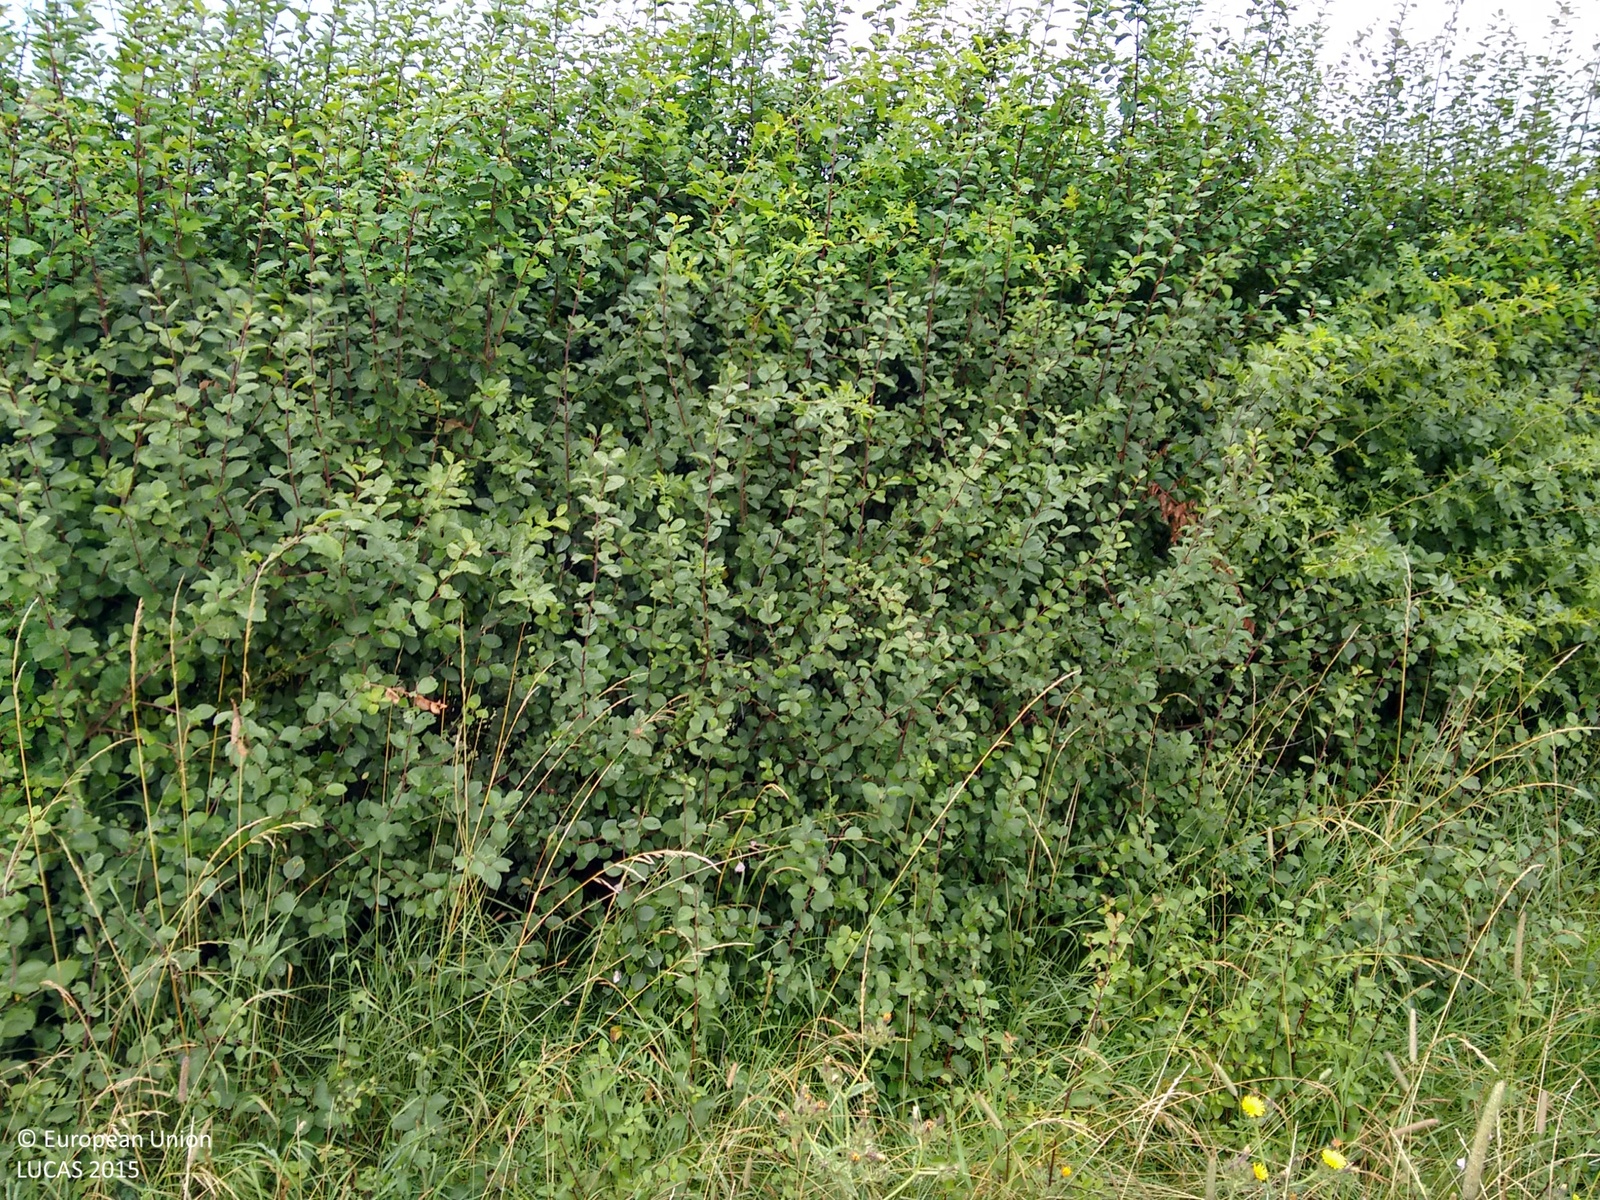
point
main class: Grassland
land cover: Grassland without tree/shrub cover
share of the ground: > 75 %
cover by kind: herbaceous plants 100 %
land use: Agriculture (excluding fallow land and kitchen gardens)
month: July
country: GB
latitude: 52.9561
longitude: -0.7735
